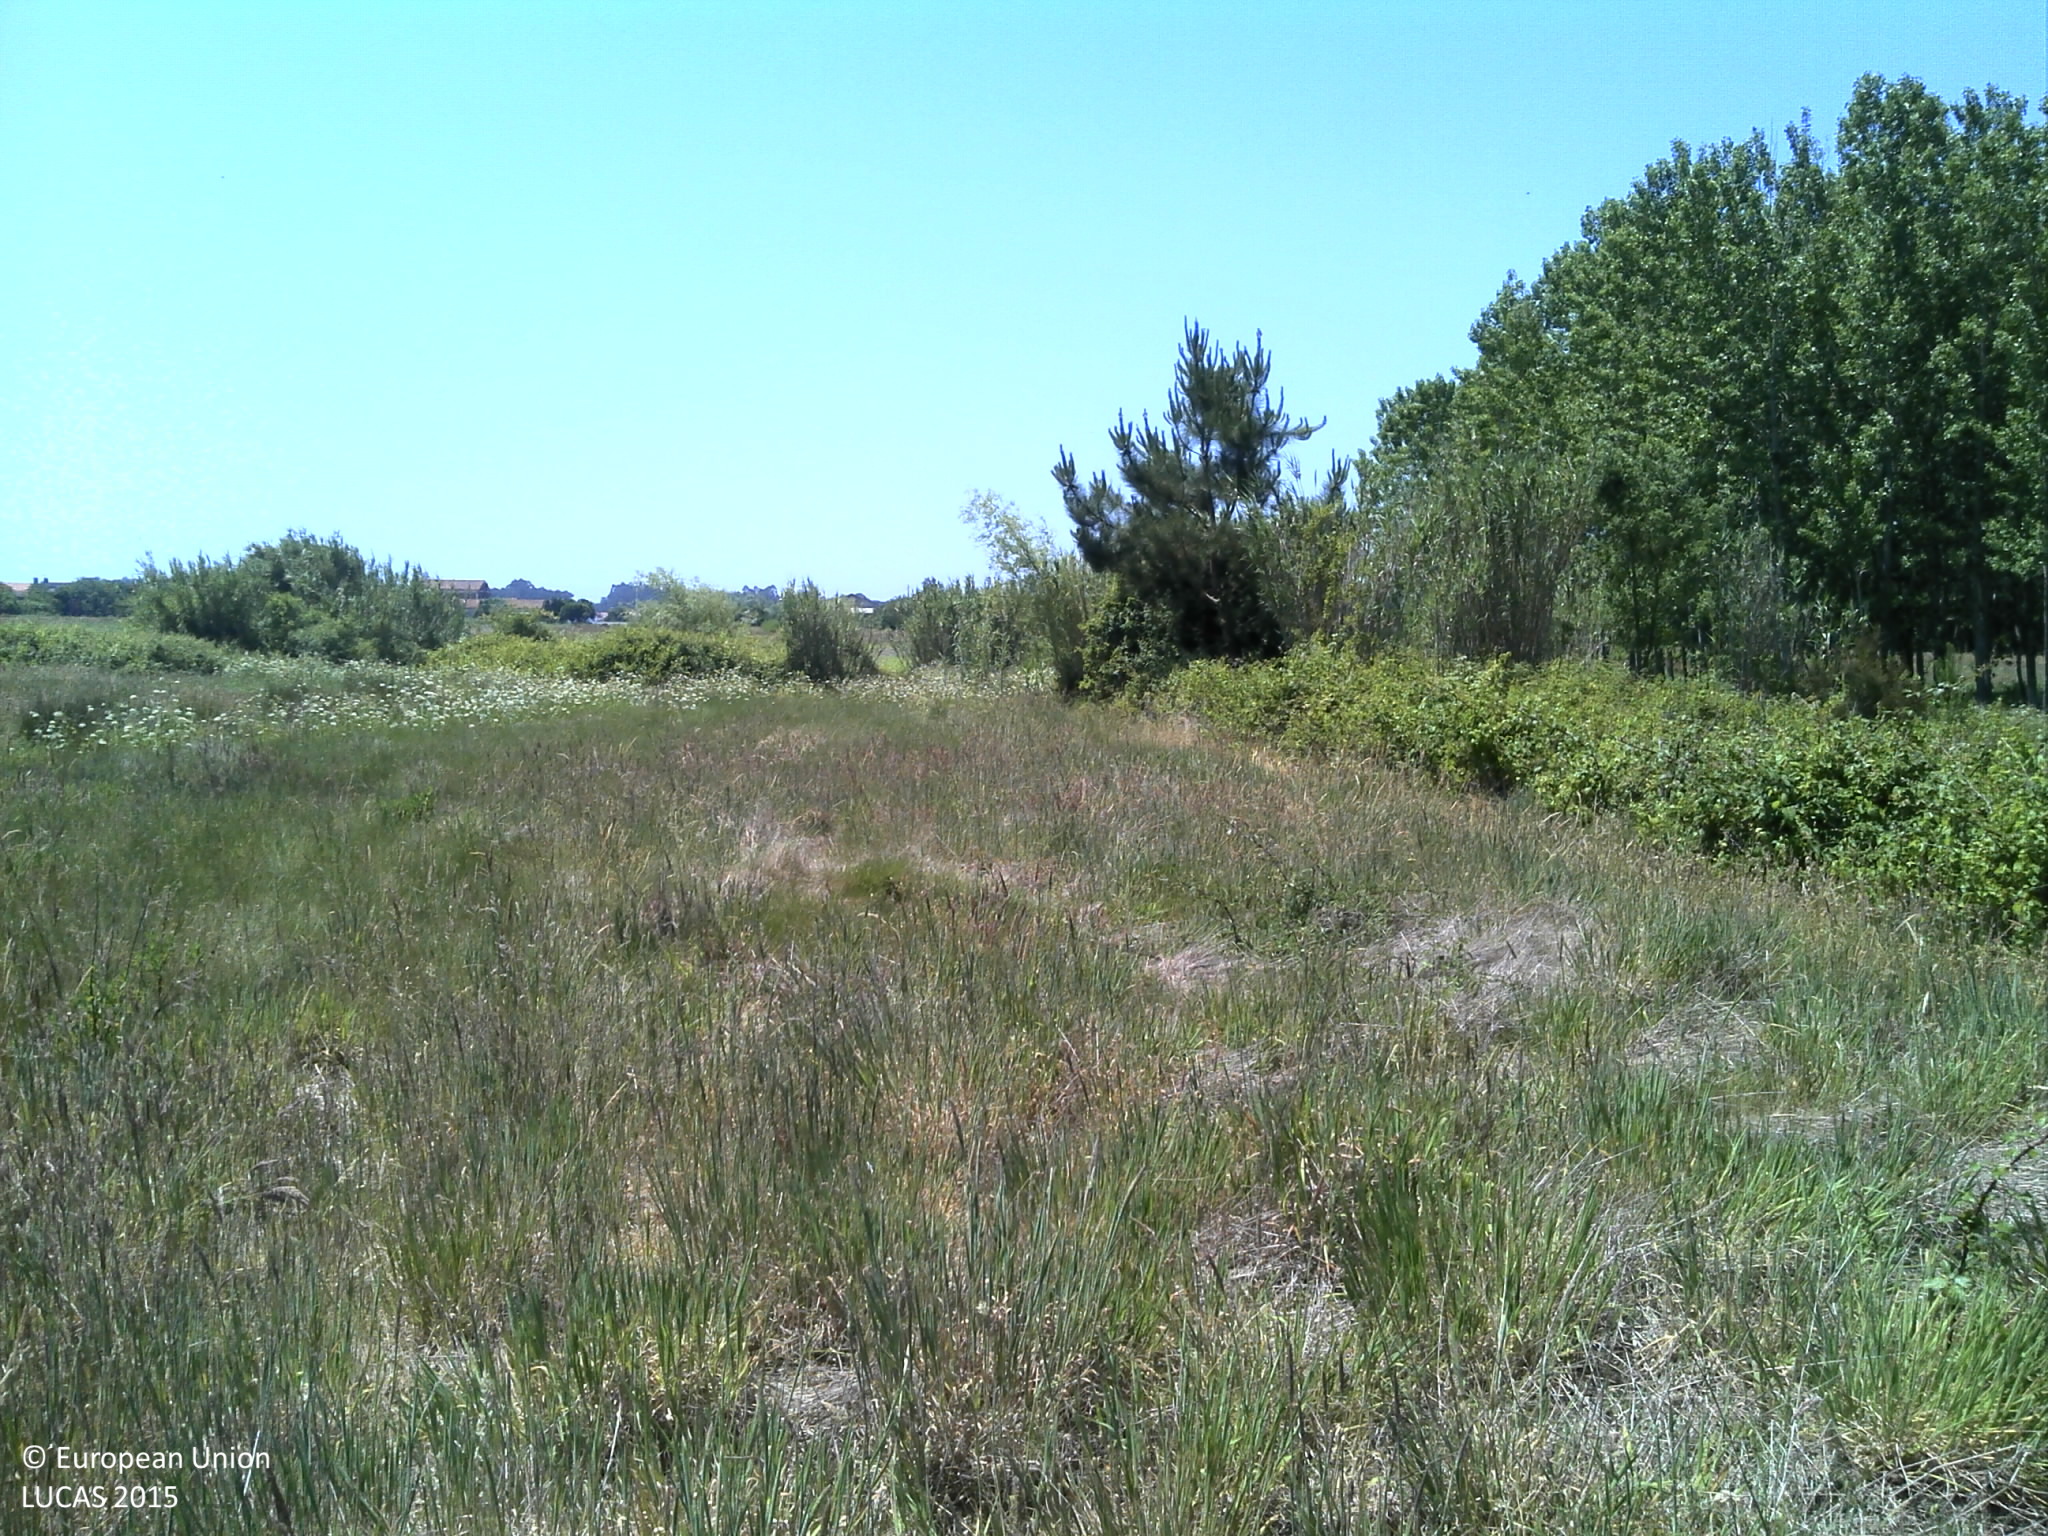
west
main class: Grassland
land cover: Grassland without tree/shrub cover
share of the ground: 50 - 75 %
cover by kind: herbaceous plants 75 %, unconsolidated bare surface 25 %
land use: Agriculture (excluding fallow land and kitchen gardens)
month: May
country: PT
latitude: 40.4432
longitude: -8.6391
